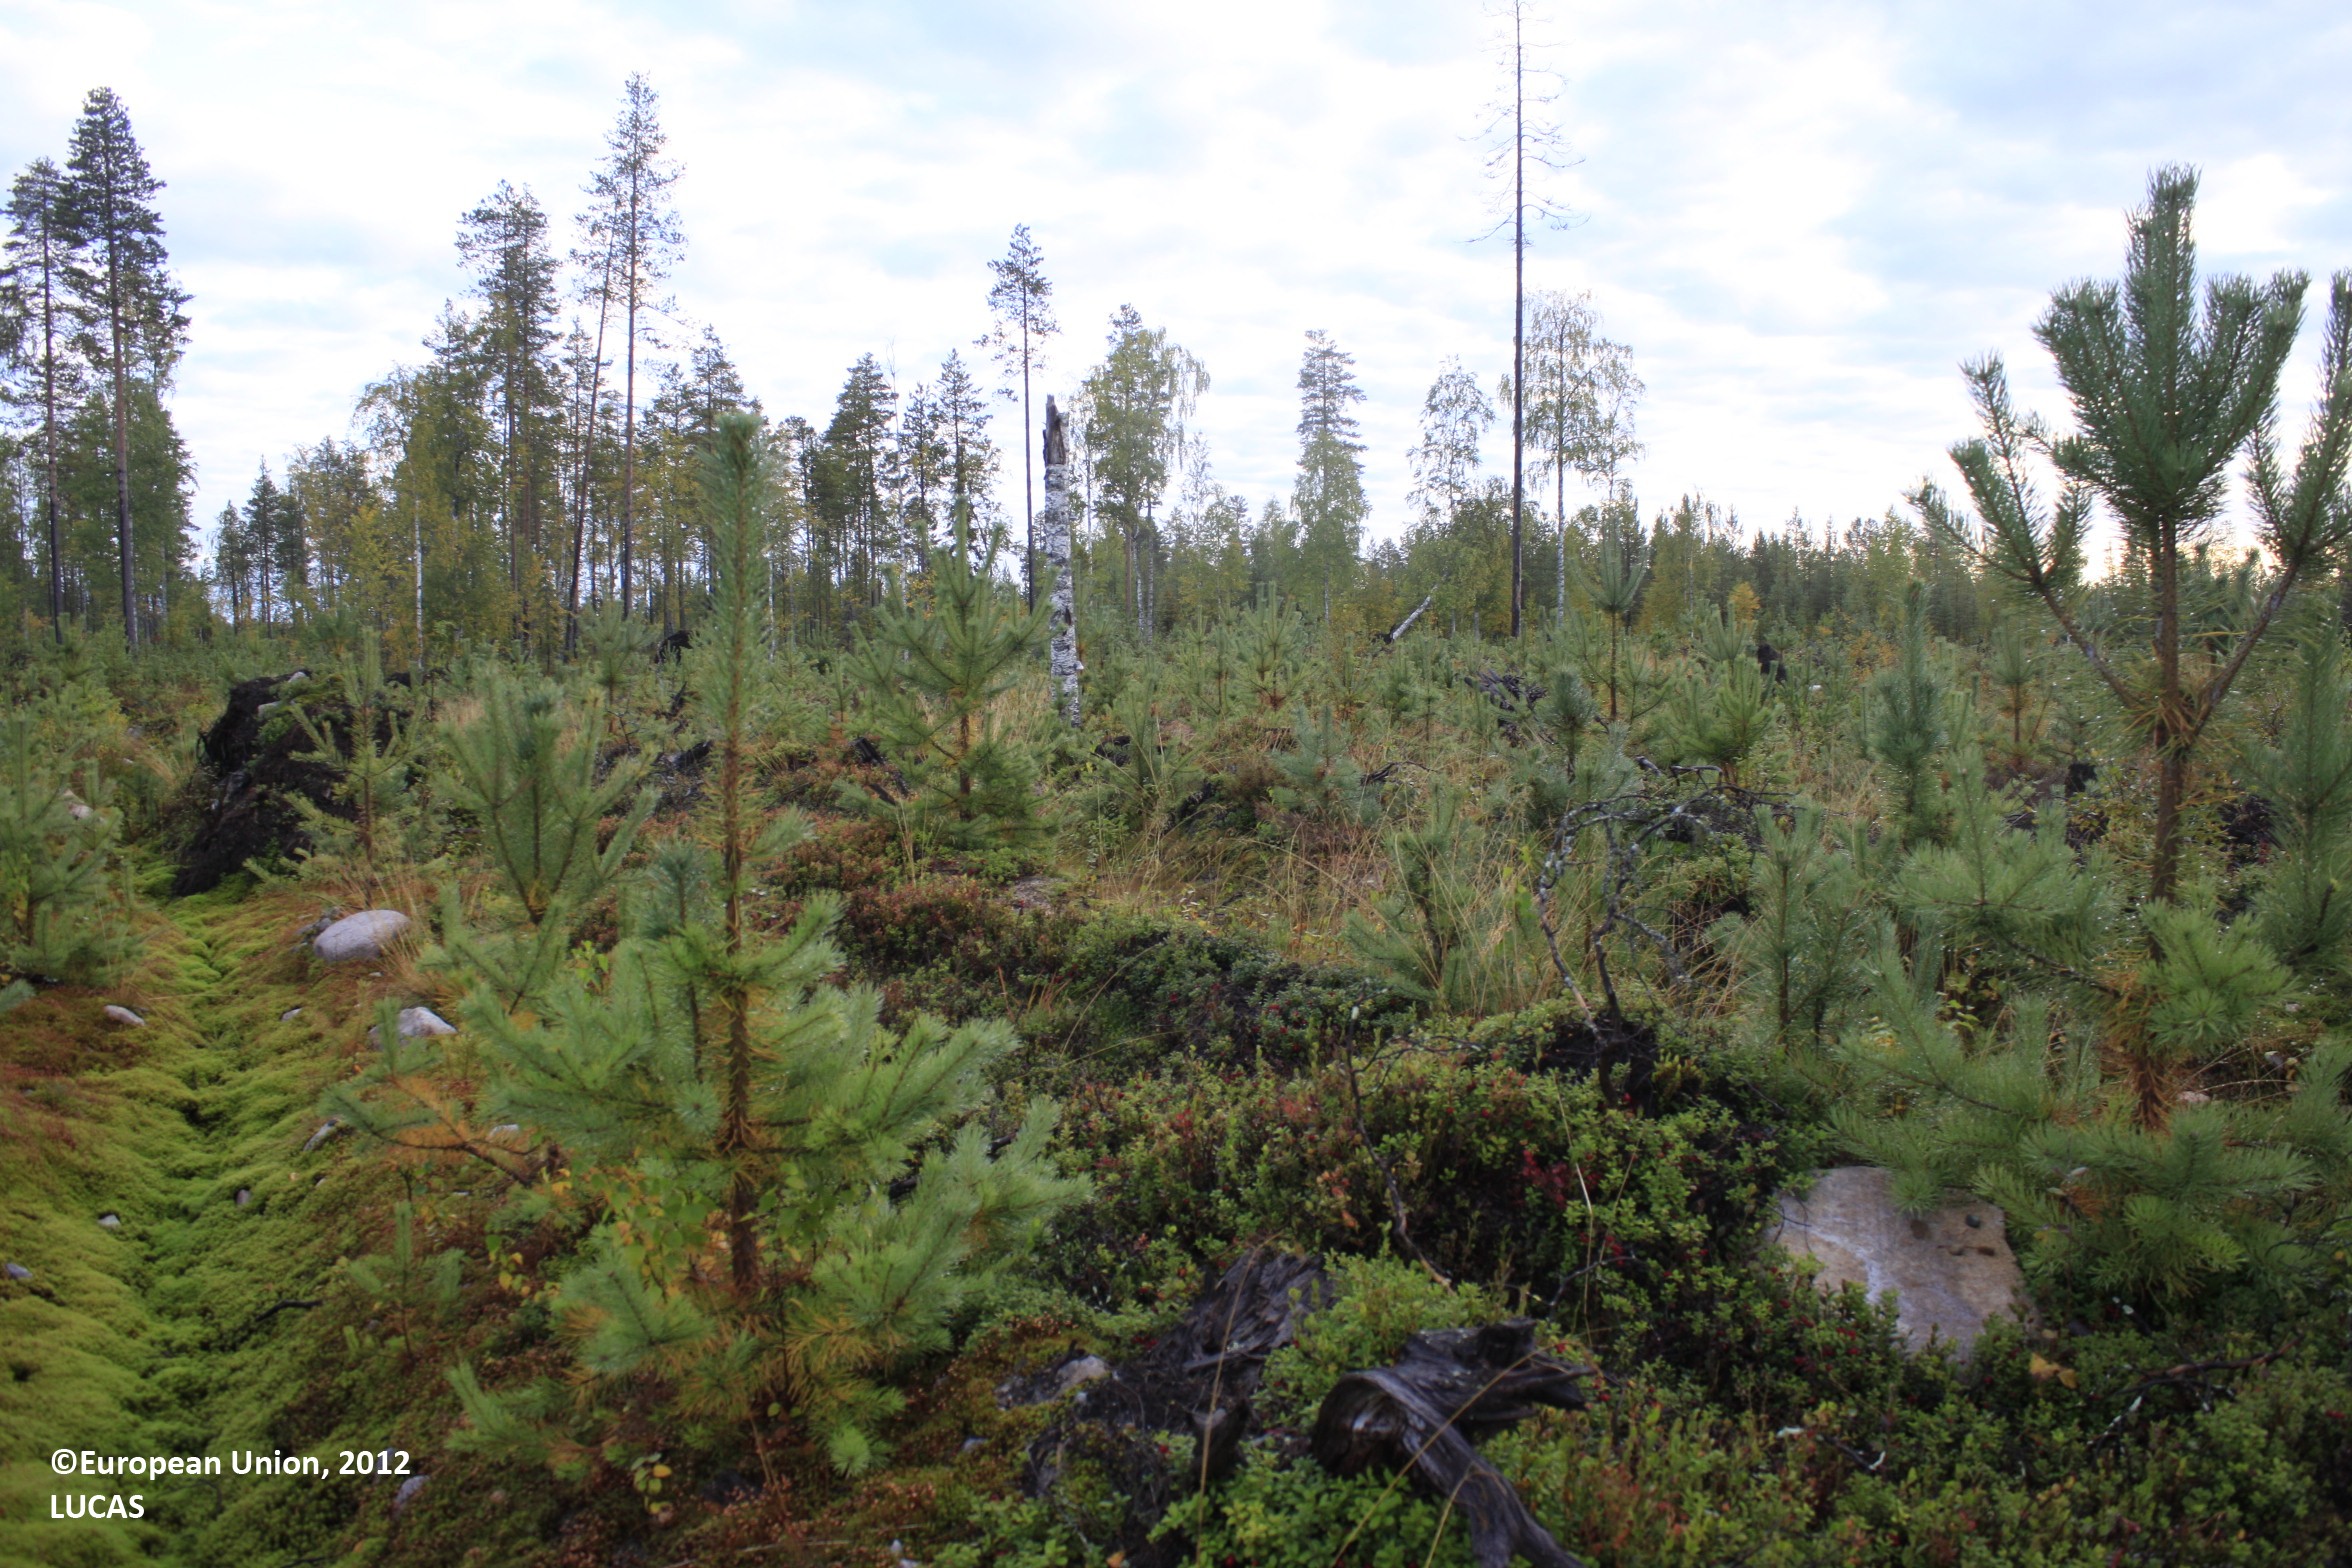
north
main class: Woodland
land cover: Pine dominated coniferous woodland
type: boreal forest
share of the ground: 25 - 50 %
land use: Forestry
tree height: < 5 m
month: September
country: FI
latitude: 65.6193
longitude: 26.7137
